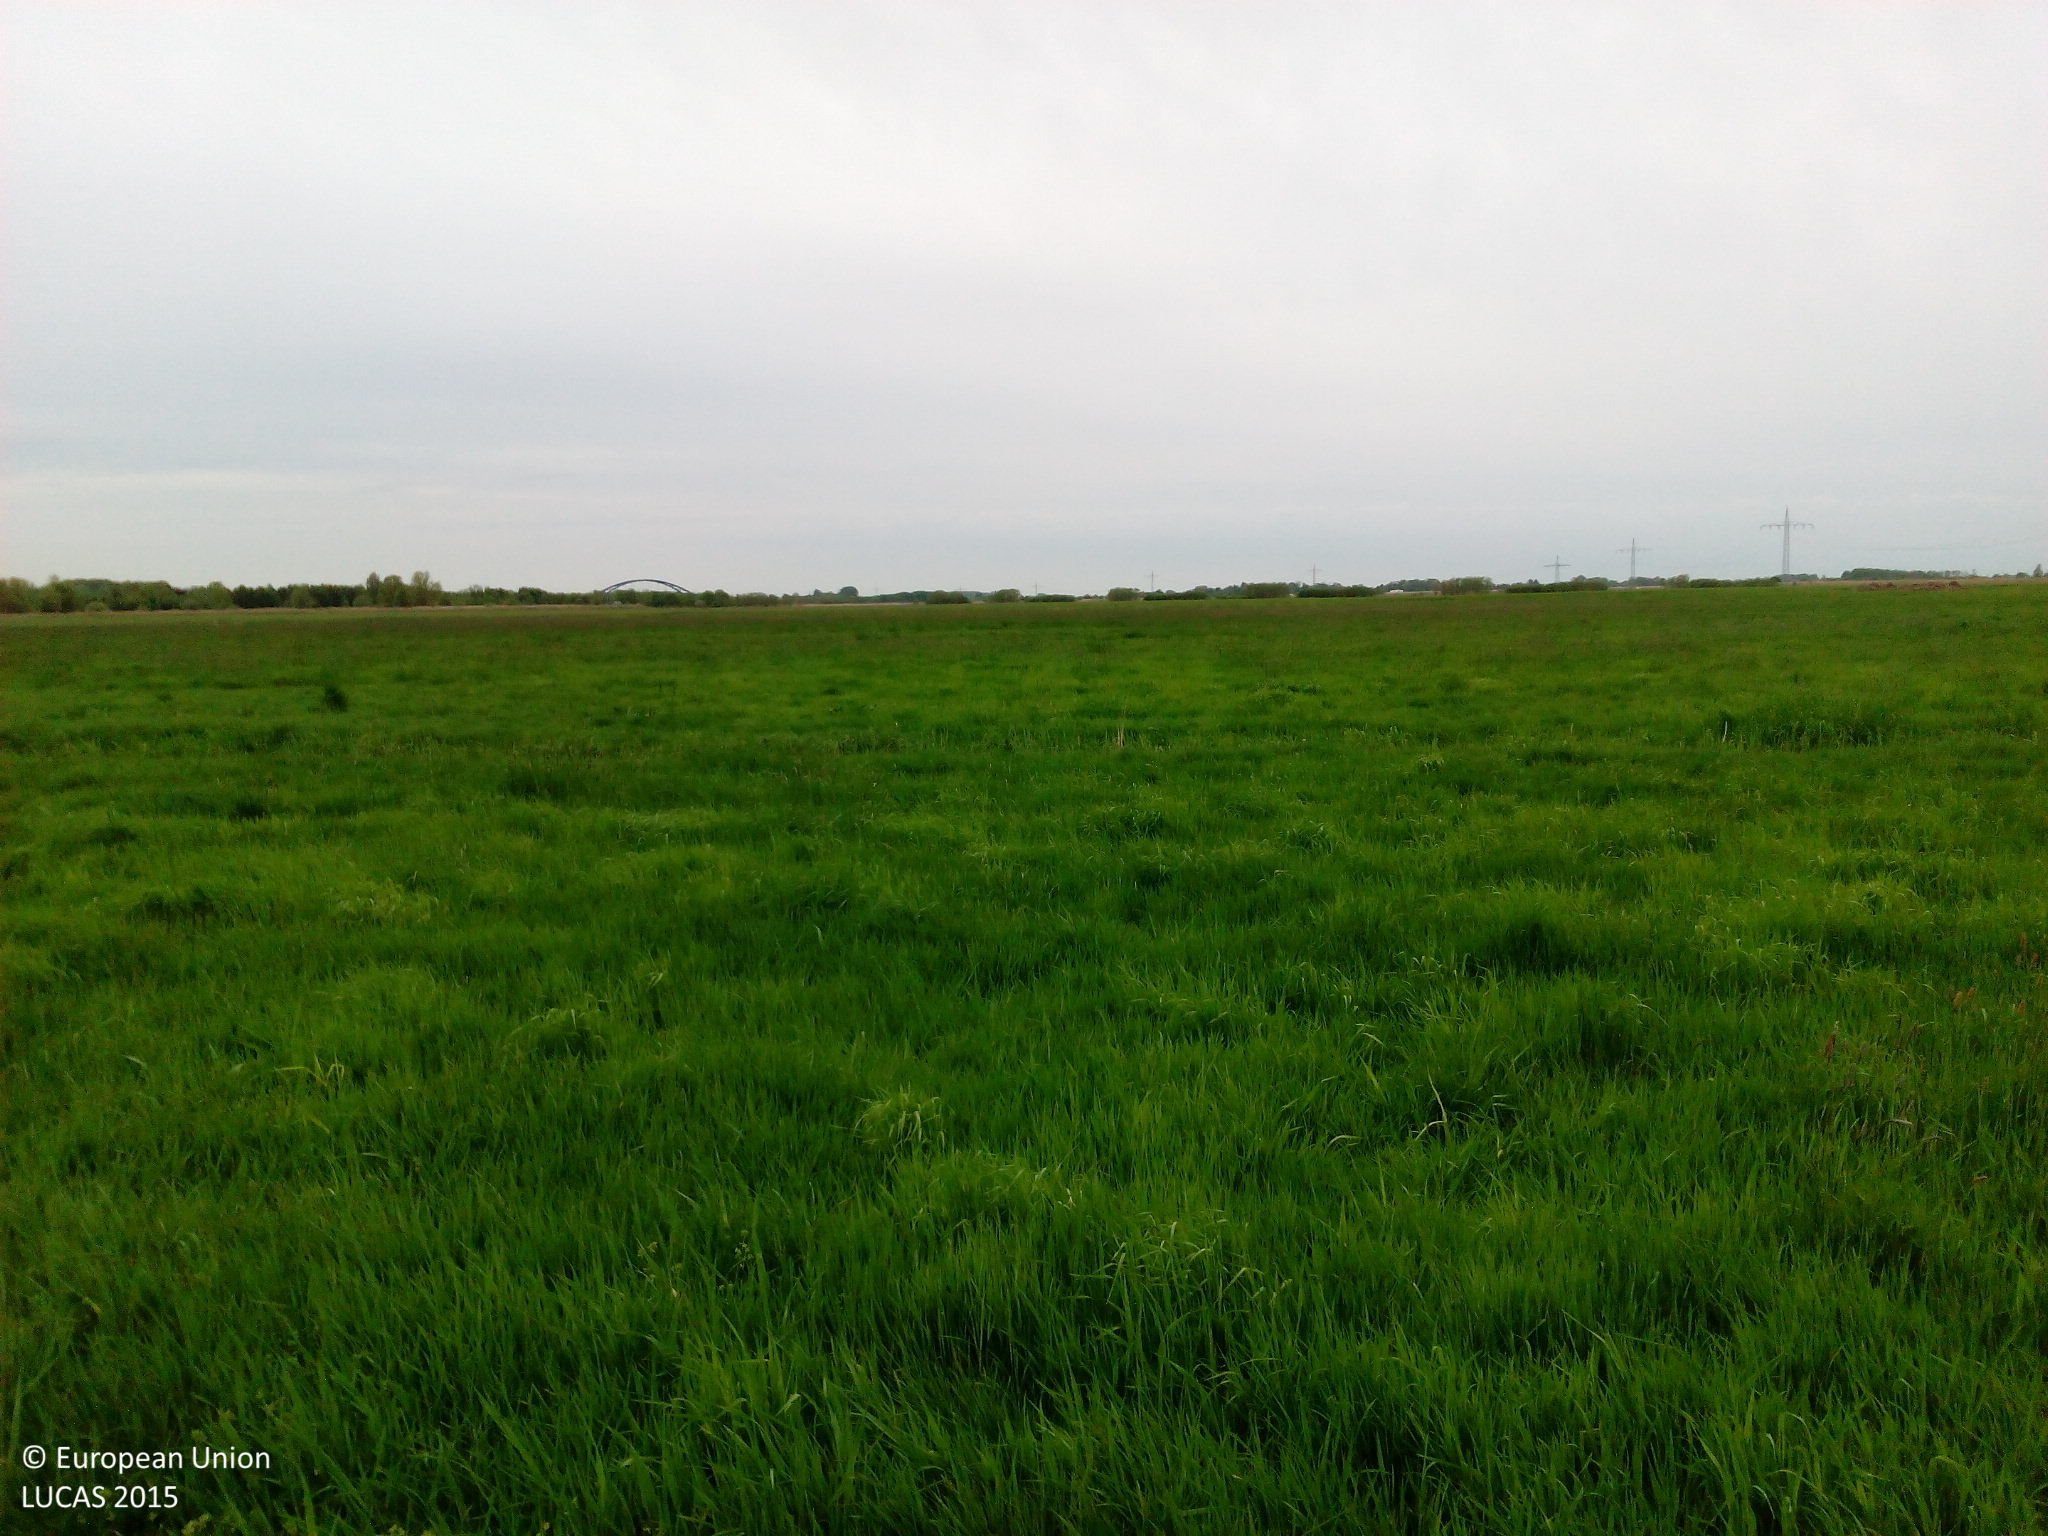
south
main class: Grassland
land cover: Grassland without tree/shrub cover
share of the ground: > 75 %
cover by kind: herbaceous plants 100 %
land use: Agriculture (excluding fallow land and kitchen gardens)
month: May
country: DE
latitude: 53.4474
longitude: 8.5702
